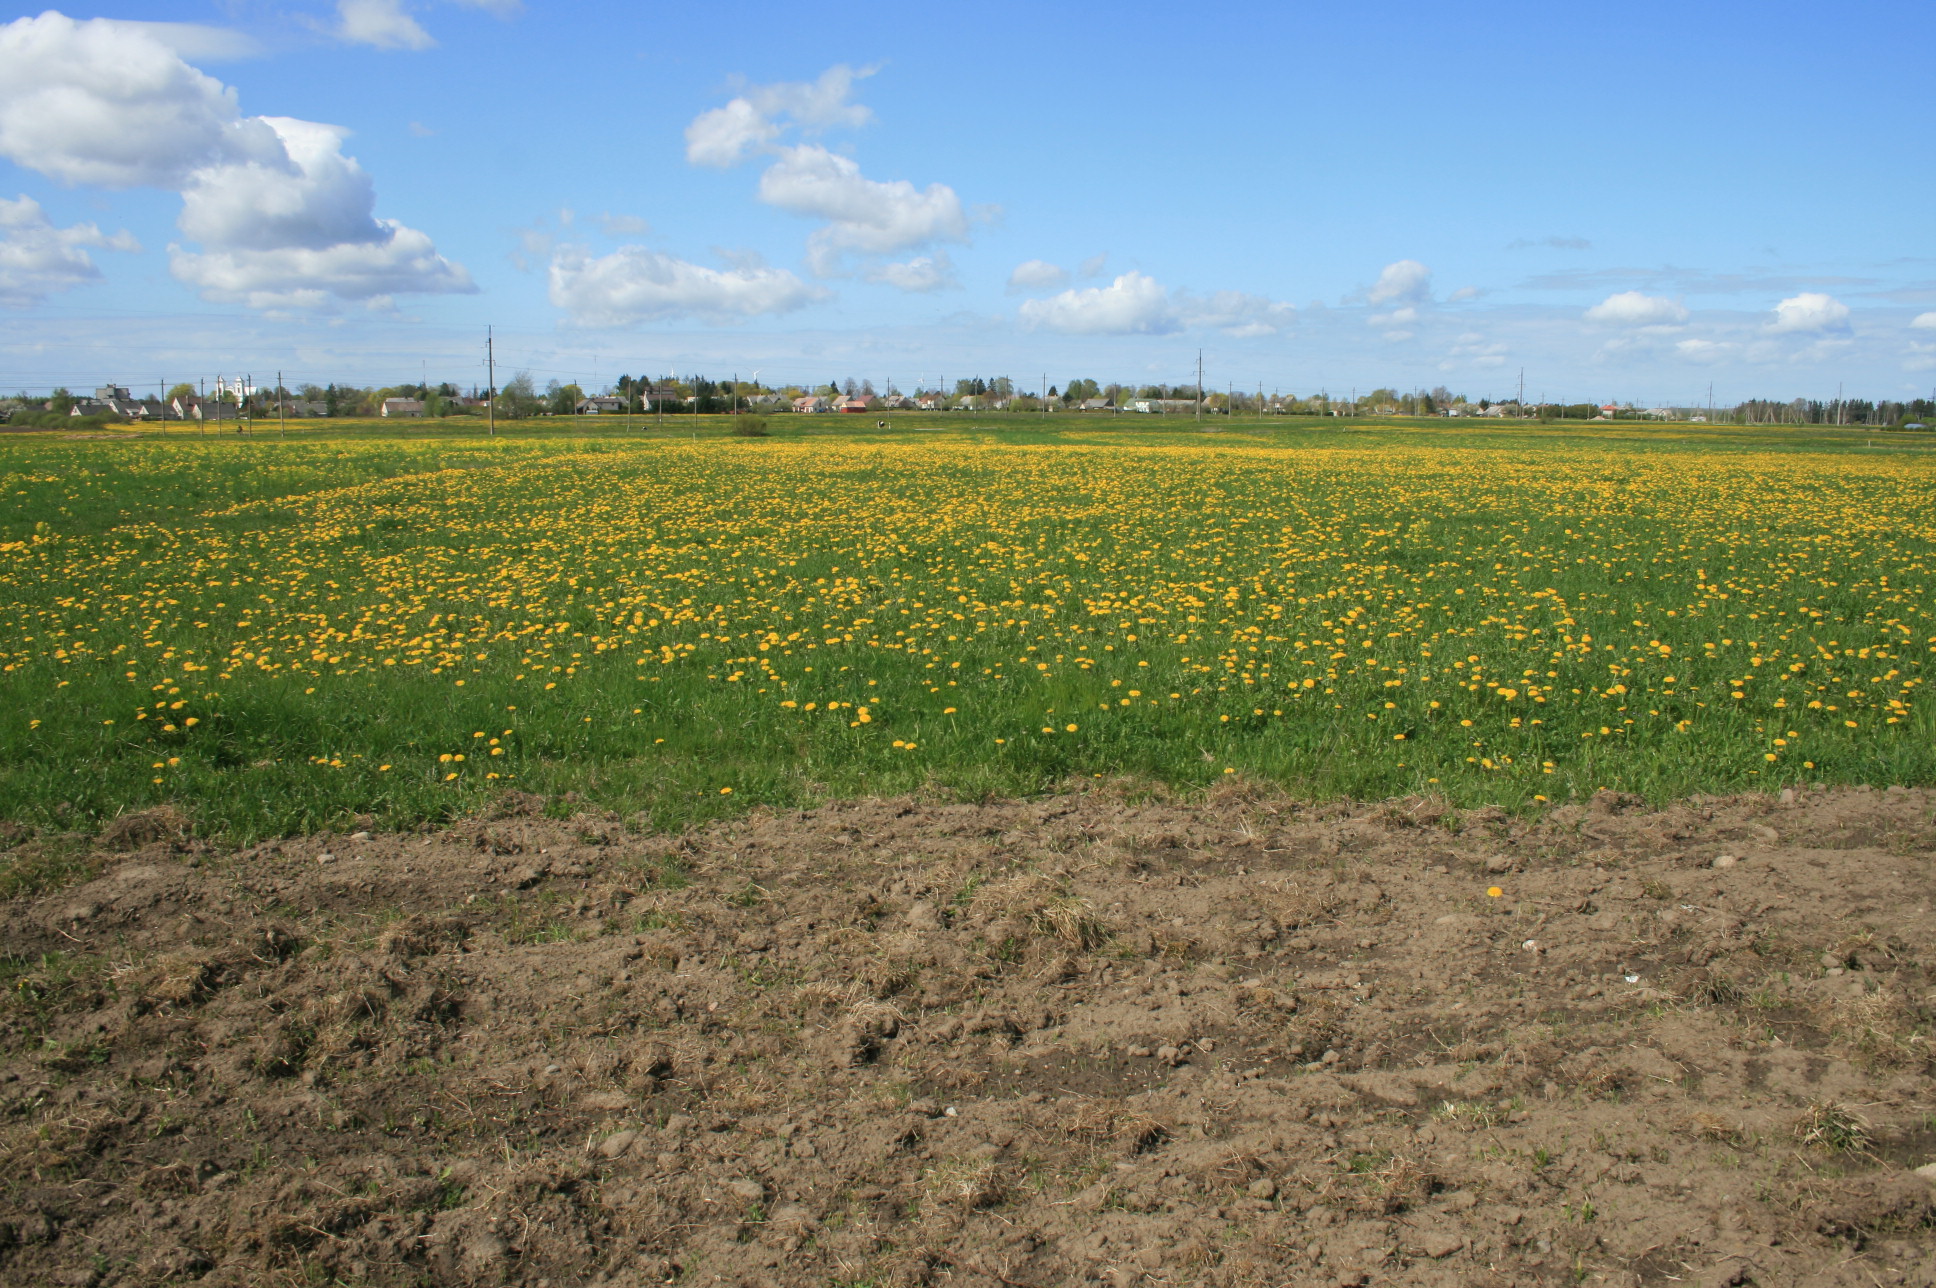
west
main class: Cropland
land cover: Oats
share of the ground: < 10 %
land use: Agriculture (excluding fallow land and kitchen gardens)
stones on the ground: < 10 %
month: May
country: LT
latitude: 56.1695
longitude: 21.5923
